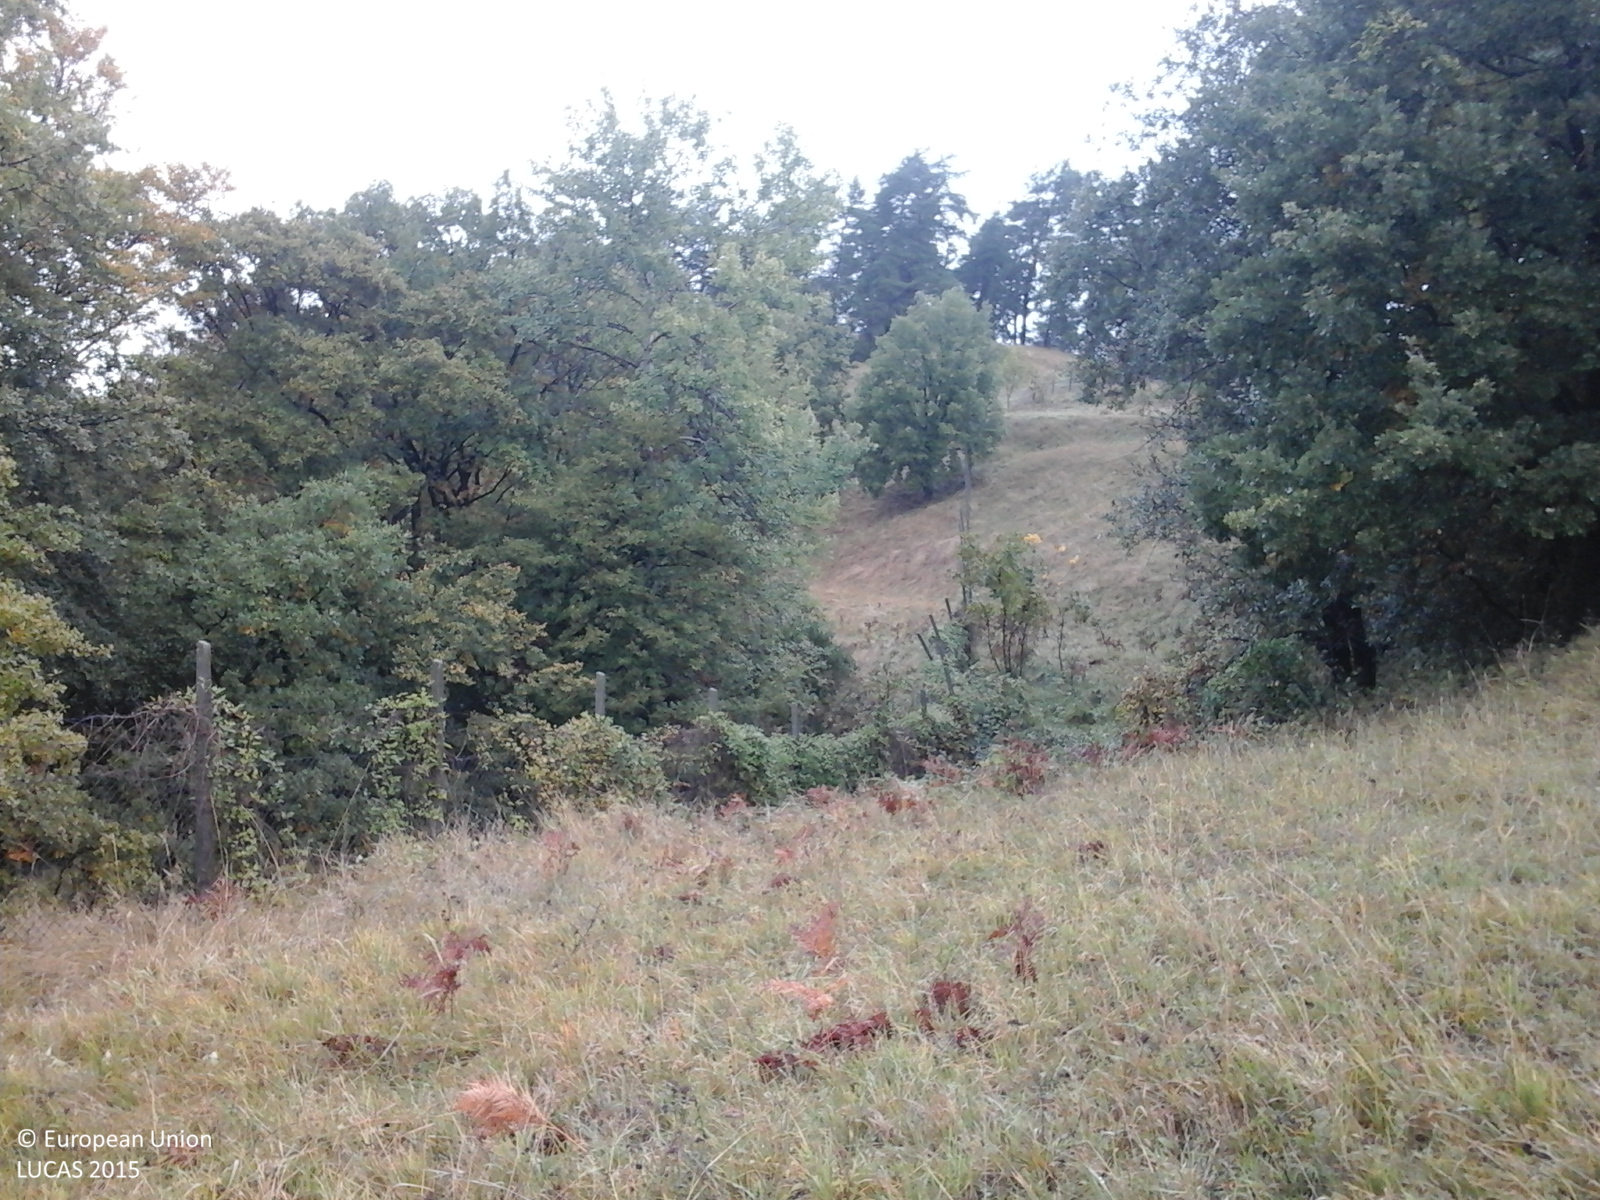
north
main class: Grassland
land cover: Grassland with sparse tree/shrub cover
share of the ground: > 75 %
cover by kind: herbaceous plants 95 %, broadleaved forest trees 5 %
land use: Agriculture (excluding fallow land and kitchen gardens)
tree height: > 5 m
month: October
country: RO
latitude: 46.1053
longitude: 24.6410
